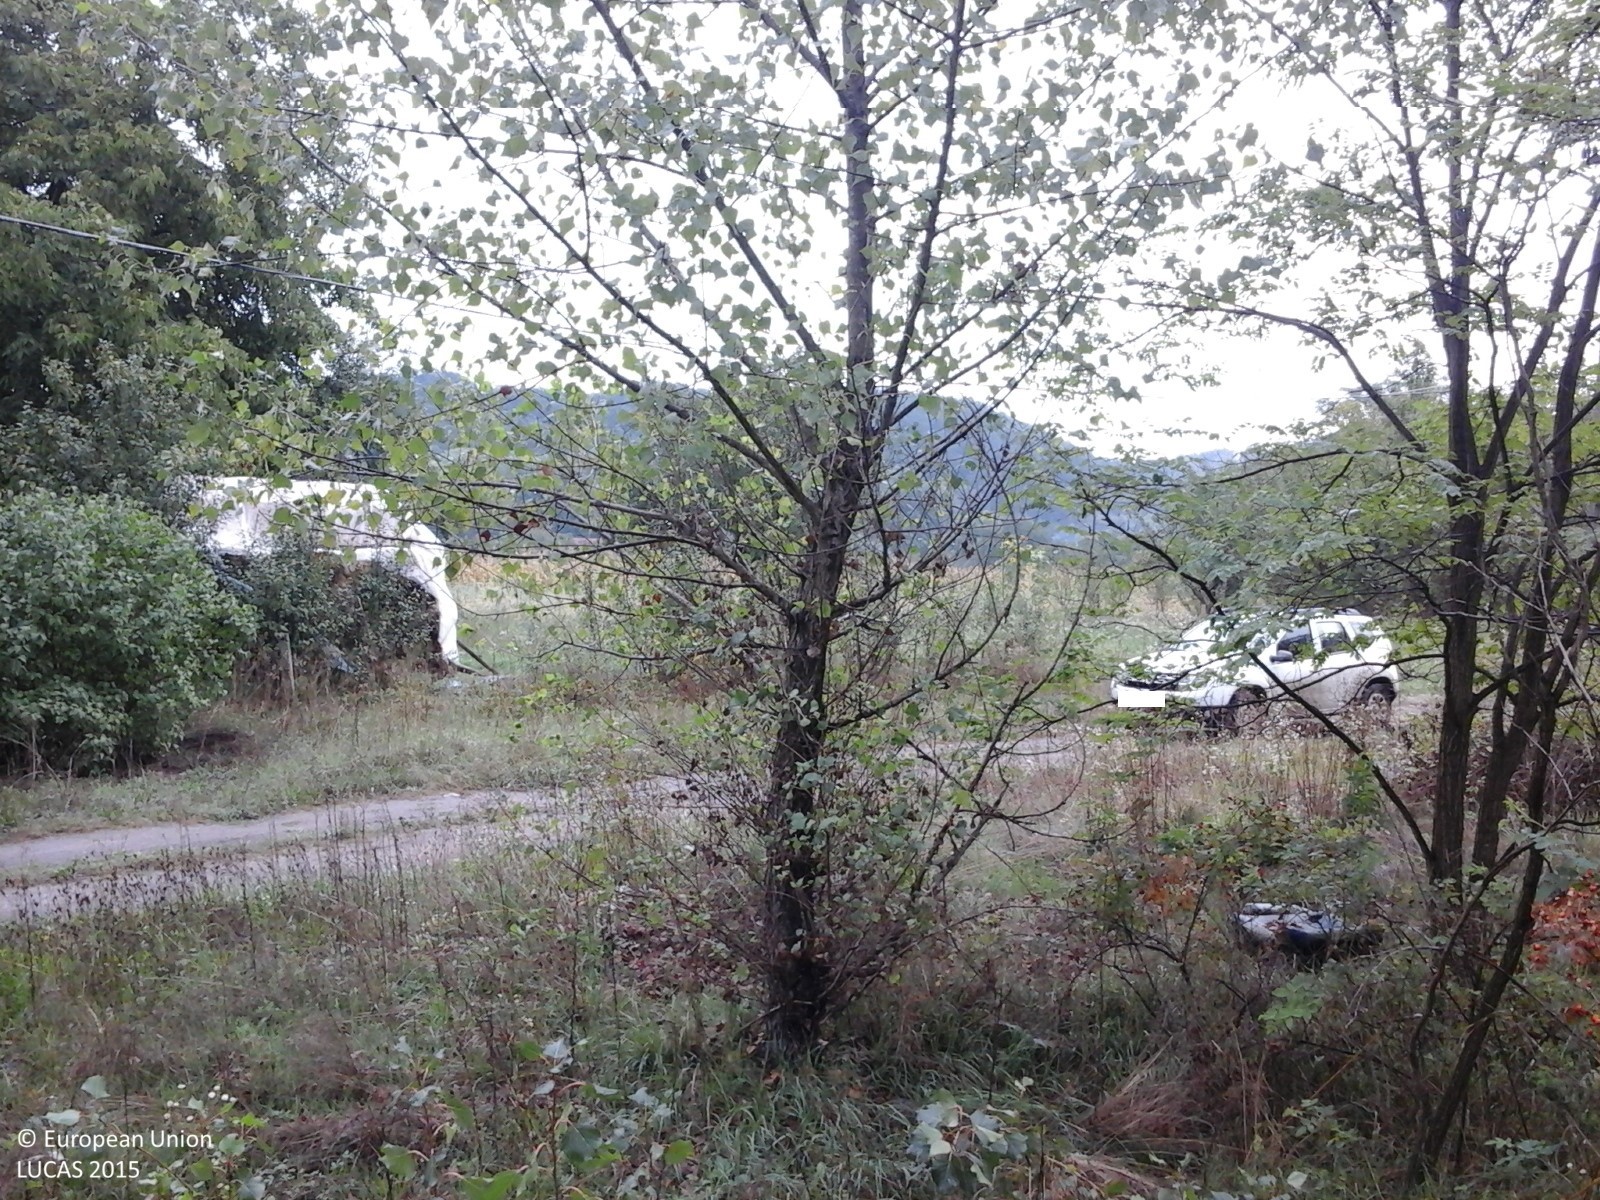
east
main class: Woodland
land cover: Broadleaved woodland
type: exotic forest
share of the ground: > 75 %
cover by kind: broadleaved forest trees 100 %
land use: Forestry
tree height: > 5 m
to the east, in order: Broadleaved woodland; Tracks; Grass margins; Electric lines; Grass margins; Fences; Spontaneously vegetated surfaces; Soya; Maize; Lucerne; Abandoned hedges; Lucerne; Artificial constructions in urban areas
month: September
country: RO
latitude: 47.0157
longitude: 22.5123
